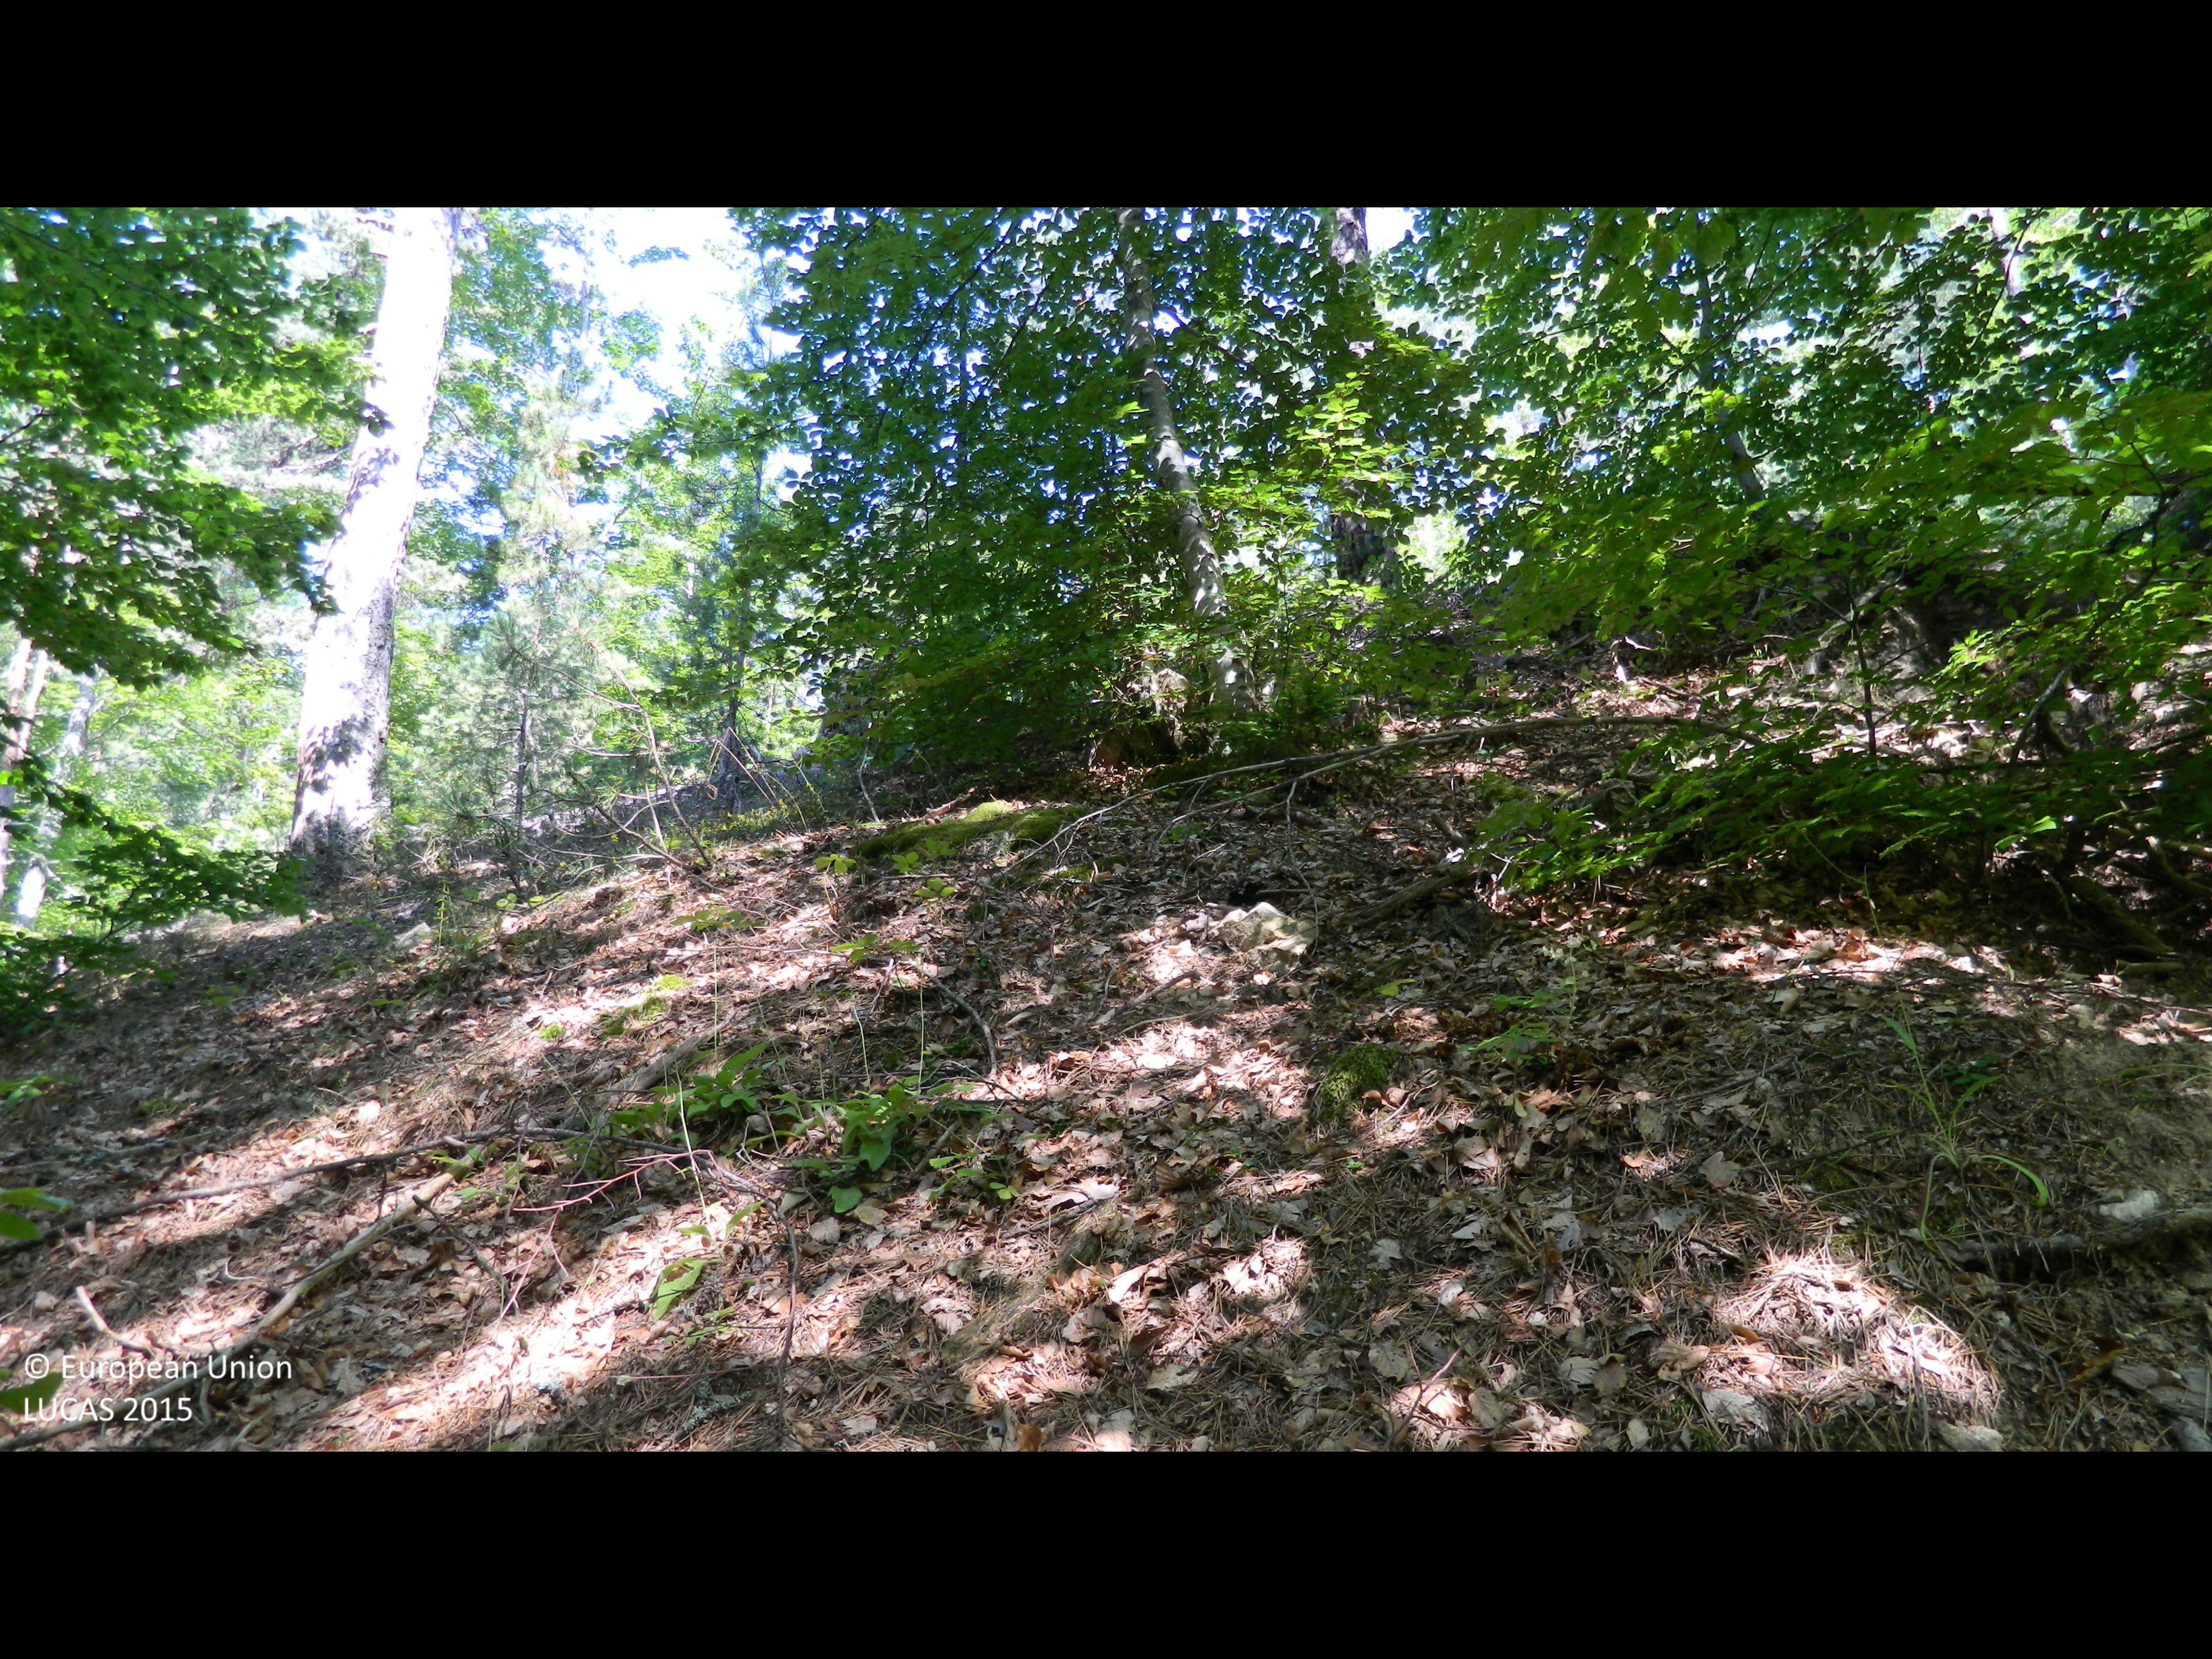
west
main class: Woodland
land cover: Broadleaved woodland
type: mountainous beech forest
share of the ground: > 75 %
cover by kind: broadleaved forest trees 85 %, coniferous forest trees 10 %, unconsolidated bare surface 5 %
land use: Forestry
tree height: > 5 m
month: July
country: BG
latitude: 41.5413
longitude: 24.8012
